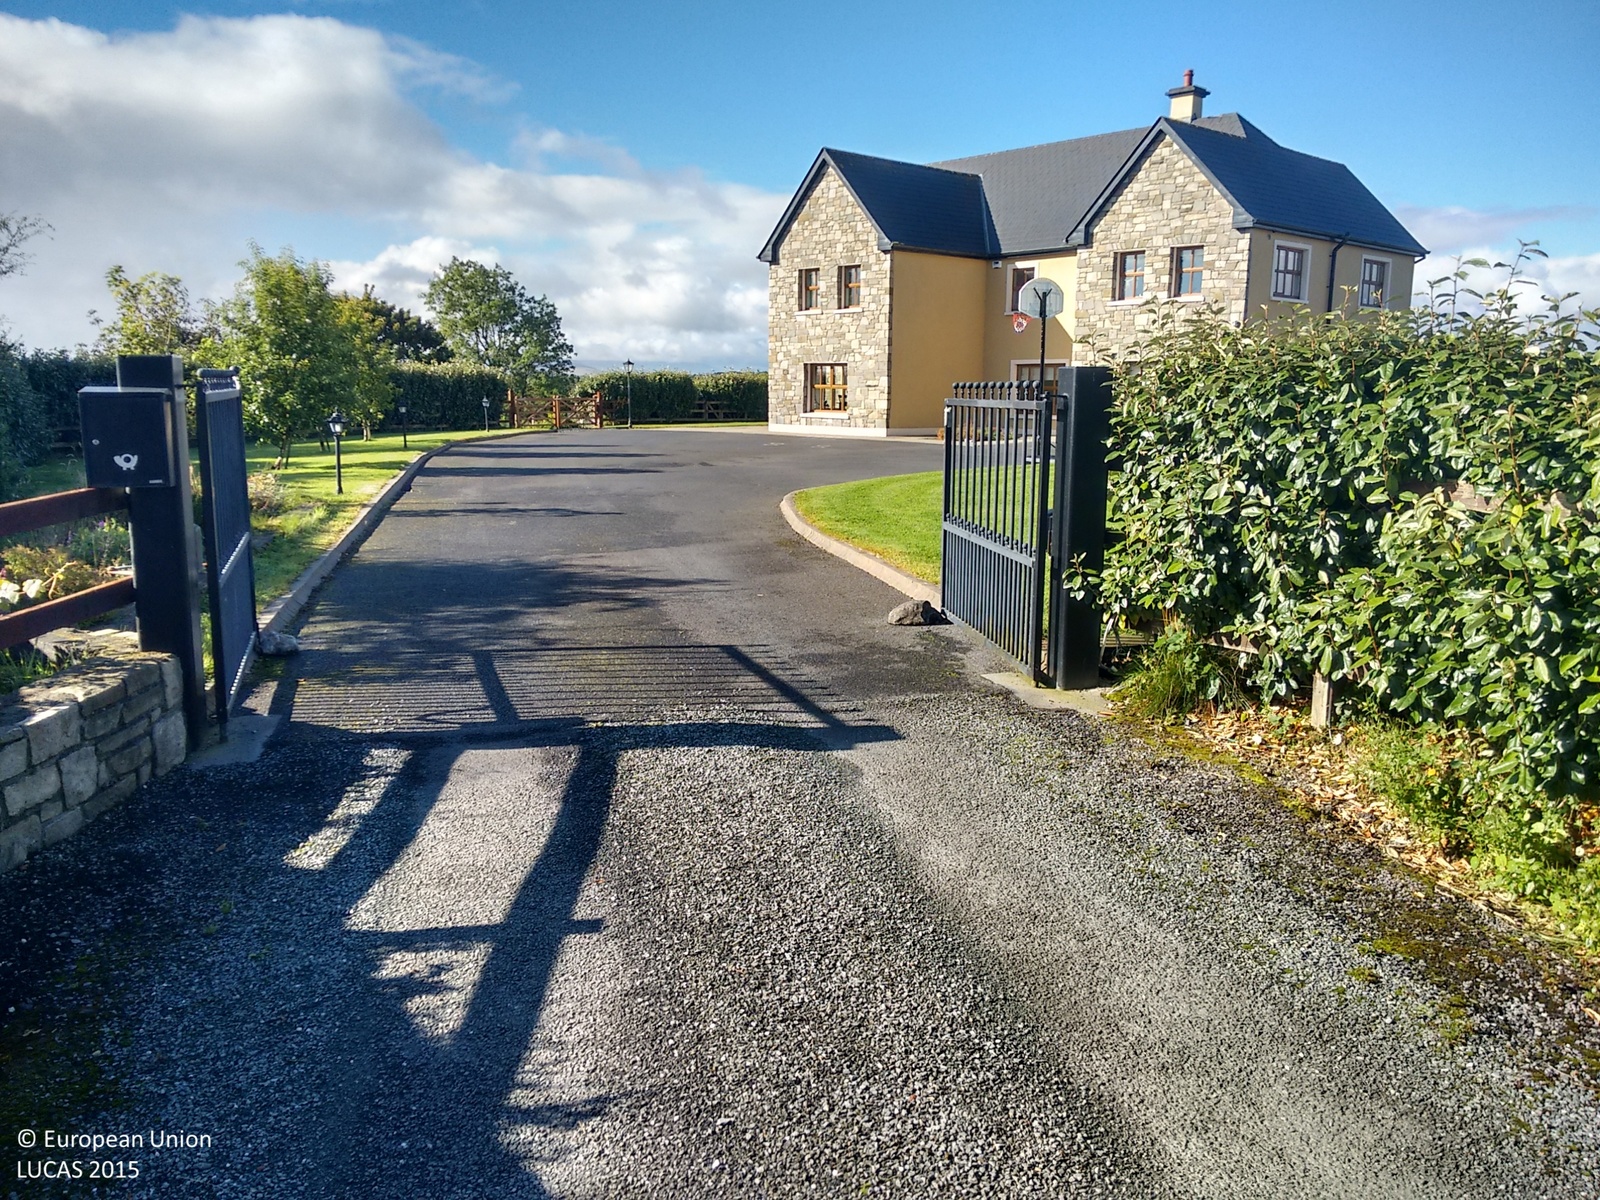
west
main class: Grassland
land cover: Grassland without tree/shrub cover
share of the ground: > 75 %
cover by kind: herbaceous plants 100 %
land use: Agriculture (excluding fallow land and kitchen gardens)
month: September
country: IE
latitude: 53.8388
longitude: -9.2325
